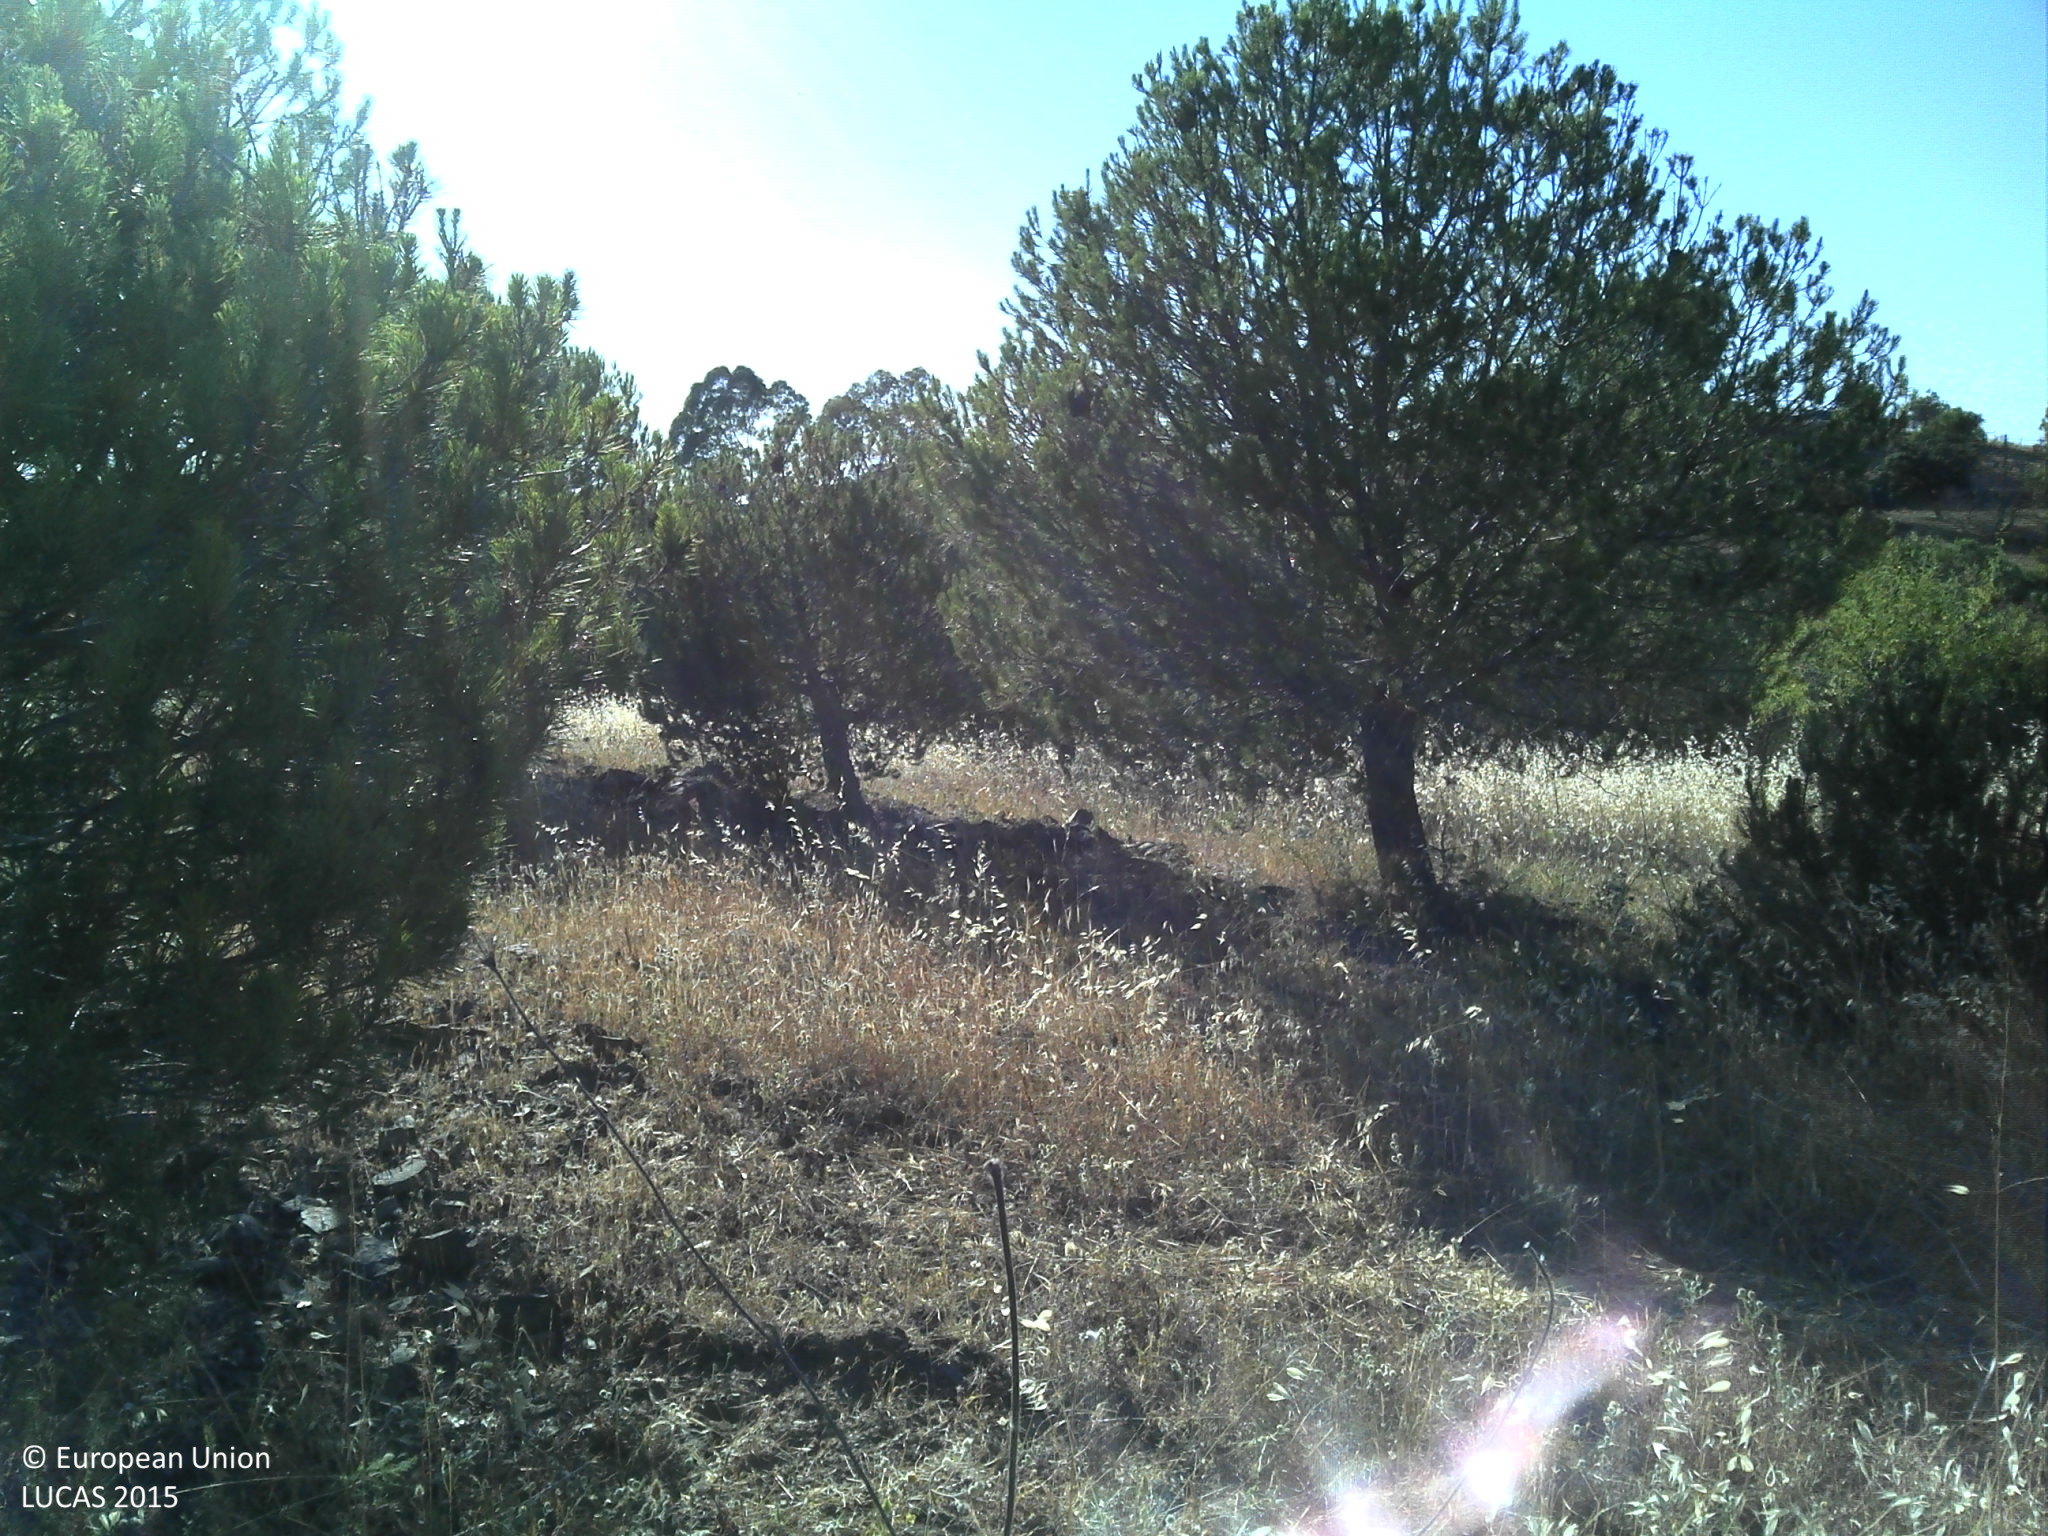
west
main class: Woodland
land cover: Pine dominated coniferous woodland
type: coniferous forest of the mediterranean region
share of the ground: 25 - 50 %
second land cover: Grassland without tree/shrub cover
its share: 50 - 75 %
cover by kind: herbaceous plants 40 %, coniferous forest trees 35 %, shrubs 25 %
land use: Forestry
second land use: Agriculture (excluding fallow land and kitchen gardens)
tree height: < 5 m
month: May
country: PT
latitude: 37.4439
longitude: -7.4938
